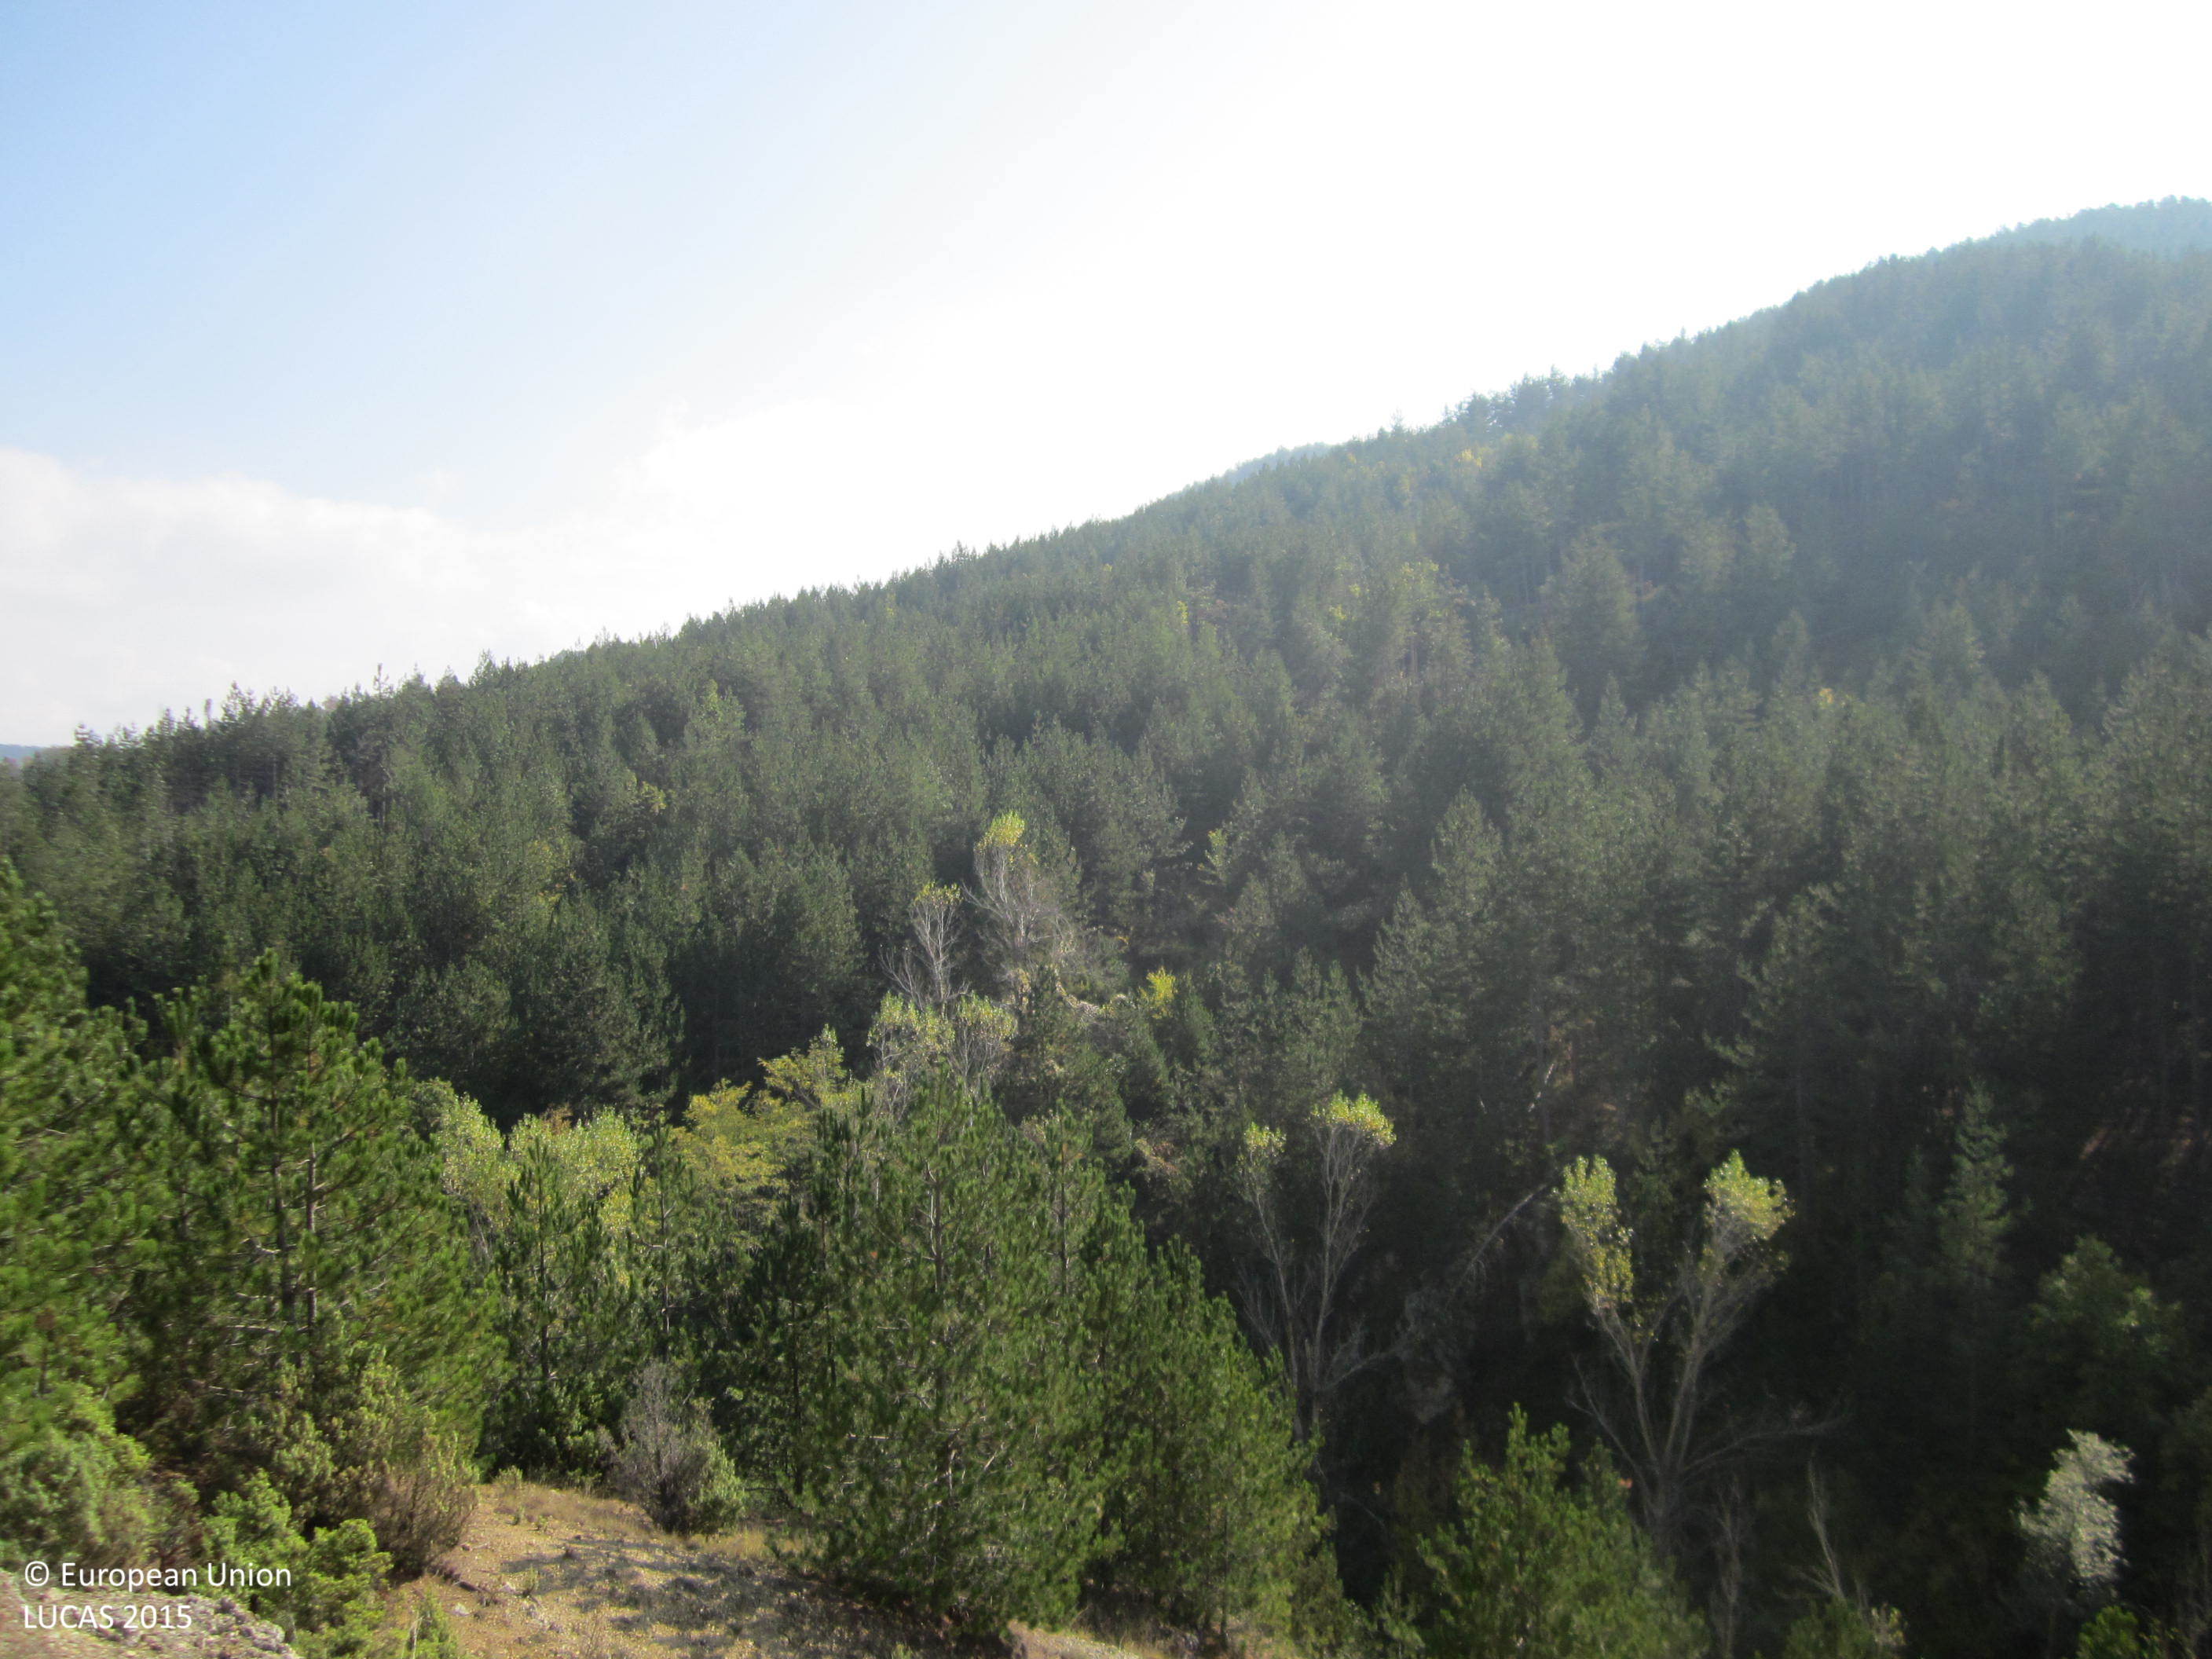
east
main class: Woodland
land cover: Pine dominated mixed woodland
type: hemiboreal forest and nemoral coniferous forest and mixed broadleaved-coniferous forest
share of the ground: 50 - 75 %
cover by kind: coniferous forest trees 50 %, broadleaved forest trees 20 %, unconsolidated bare surface 15 %, herbaceous plants 10 %, shrubs 5 %
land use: Semi-natural and natural areas not in use
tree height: > 5 m
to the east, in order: Pine dominated mixed woodland; Rivers and streams; Pine dominated mixed woodland; Pine dominated coniferous woodland
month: October
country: BG
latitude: 41.4322
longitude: 25.6282
